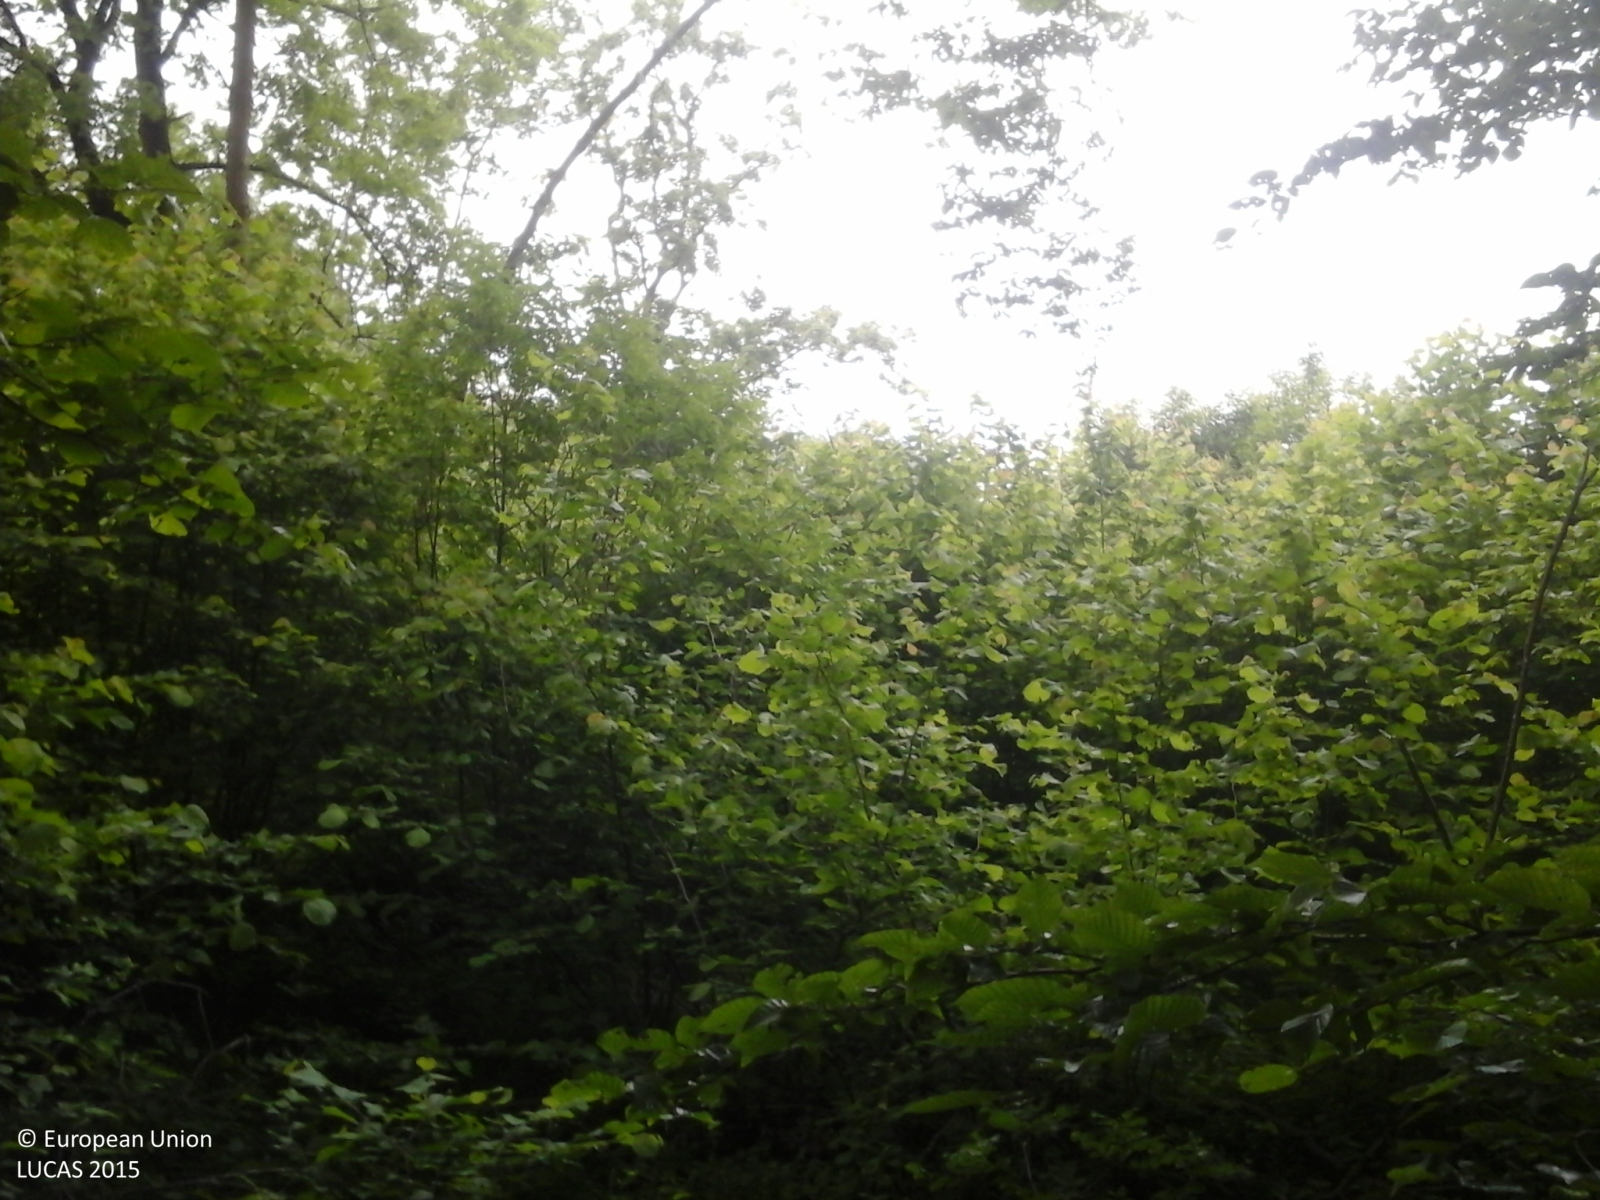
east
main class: Woodland
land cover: Broadleaved woodland
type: mesophytic deciduous forest
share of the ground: > 75 %
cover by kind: broadleaved forest trees 60 %, shrubs 40 %
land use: Forestry
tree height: > 5 m
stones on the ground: < 10 %
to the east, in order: Broadleaved woodland; Tracks; Broadleaved woodland; Electric lines; Broadleaved woodland
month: May
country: IT
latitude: 45.8424
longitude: 10.9642
